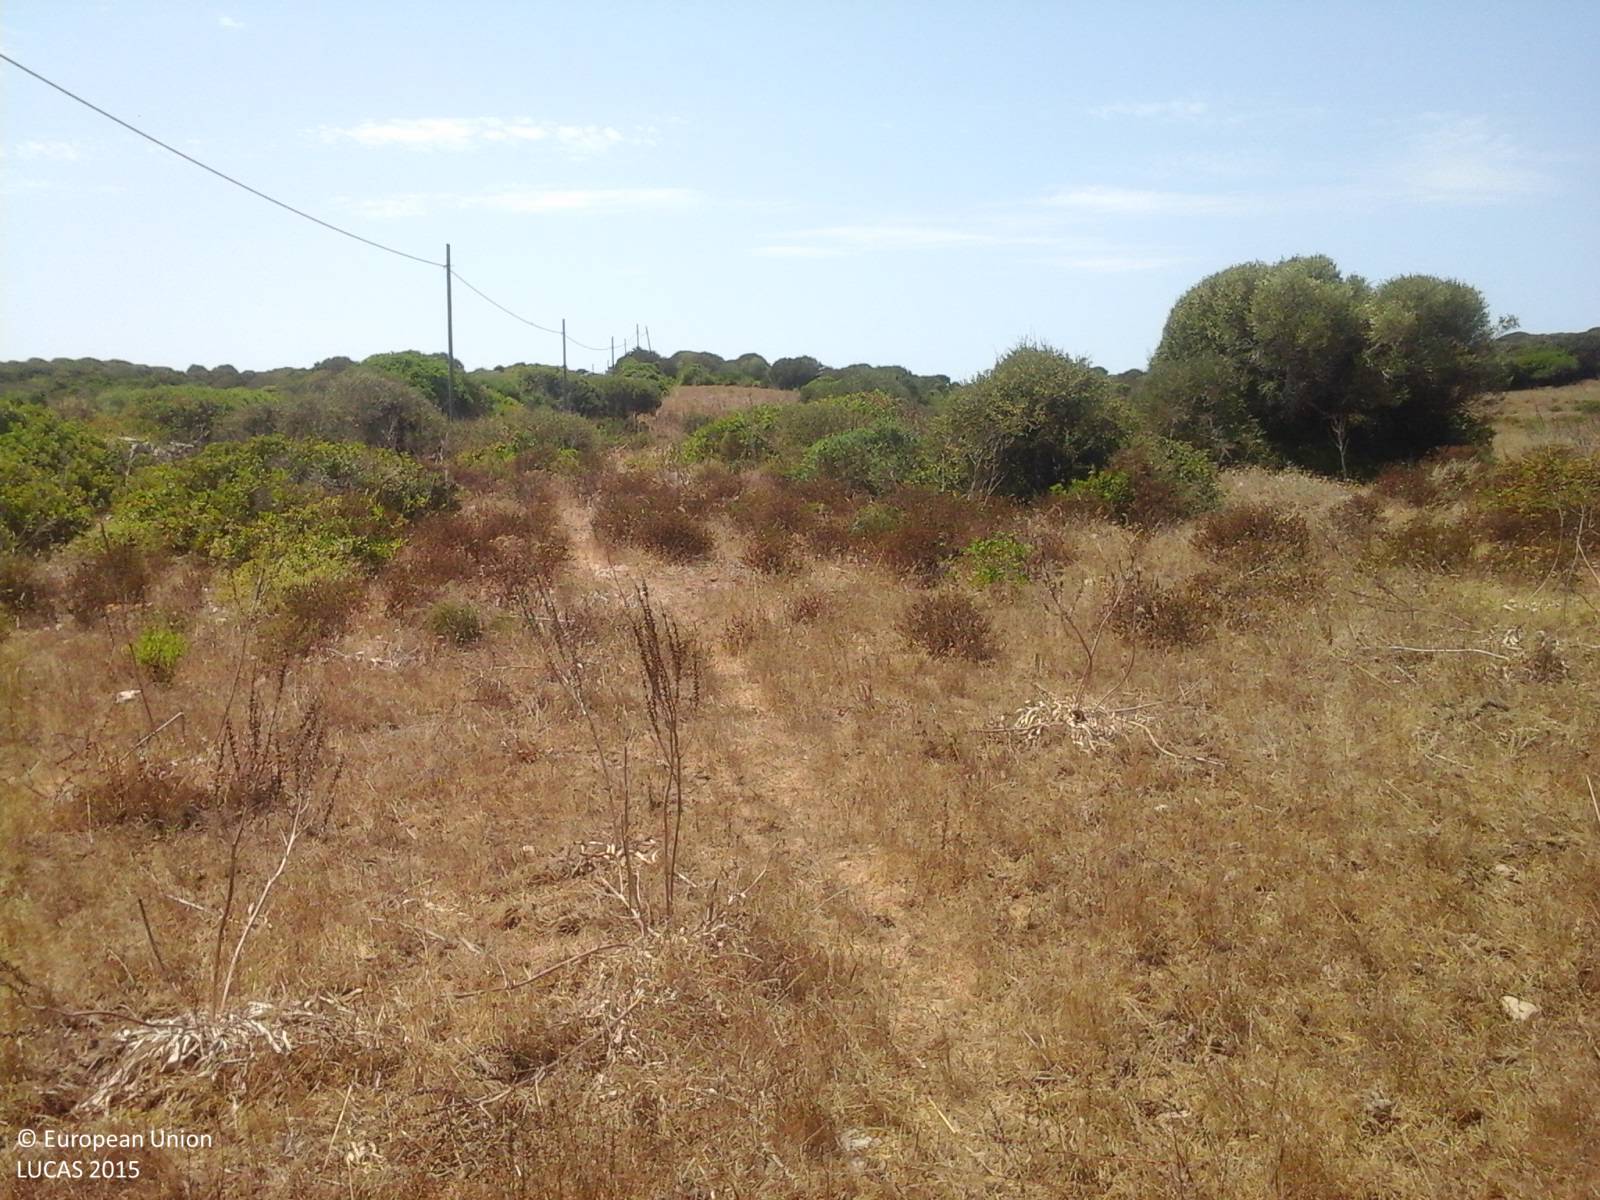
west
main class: Grassland
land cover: Grassland without tree/shrub cover
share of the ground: 25 - 50 %
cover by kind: herbaceous plants 100 %
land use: Agriculture (excluding fallow land and kitchen gardens)
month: July
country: IT
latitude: 41.2048
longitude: 9.1808
